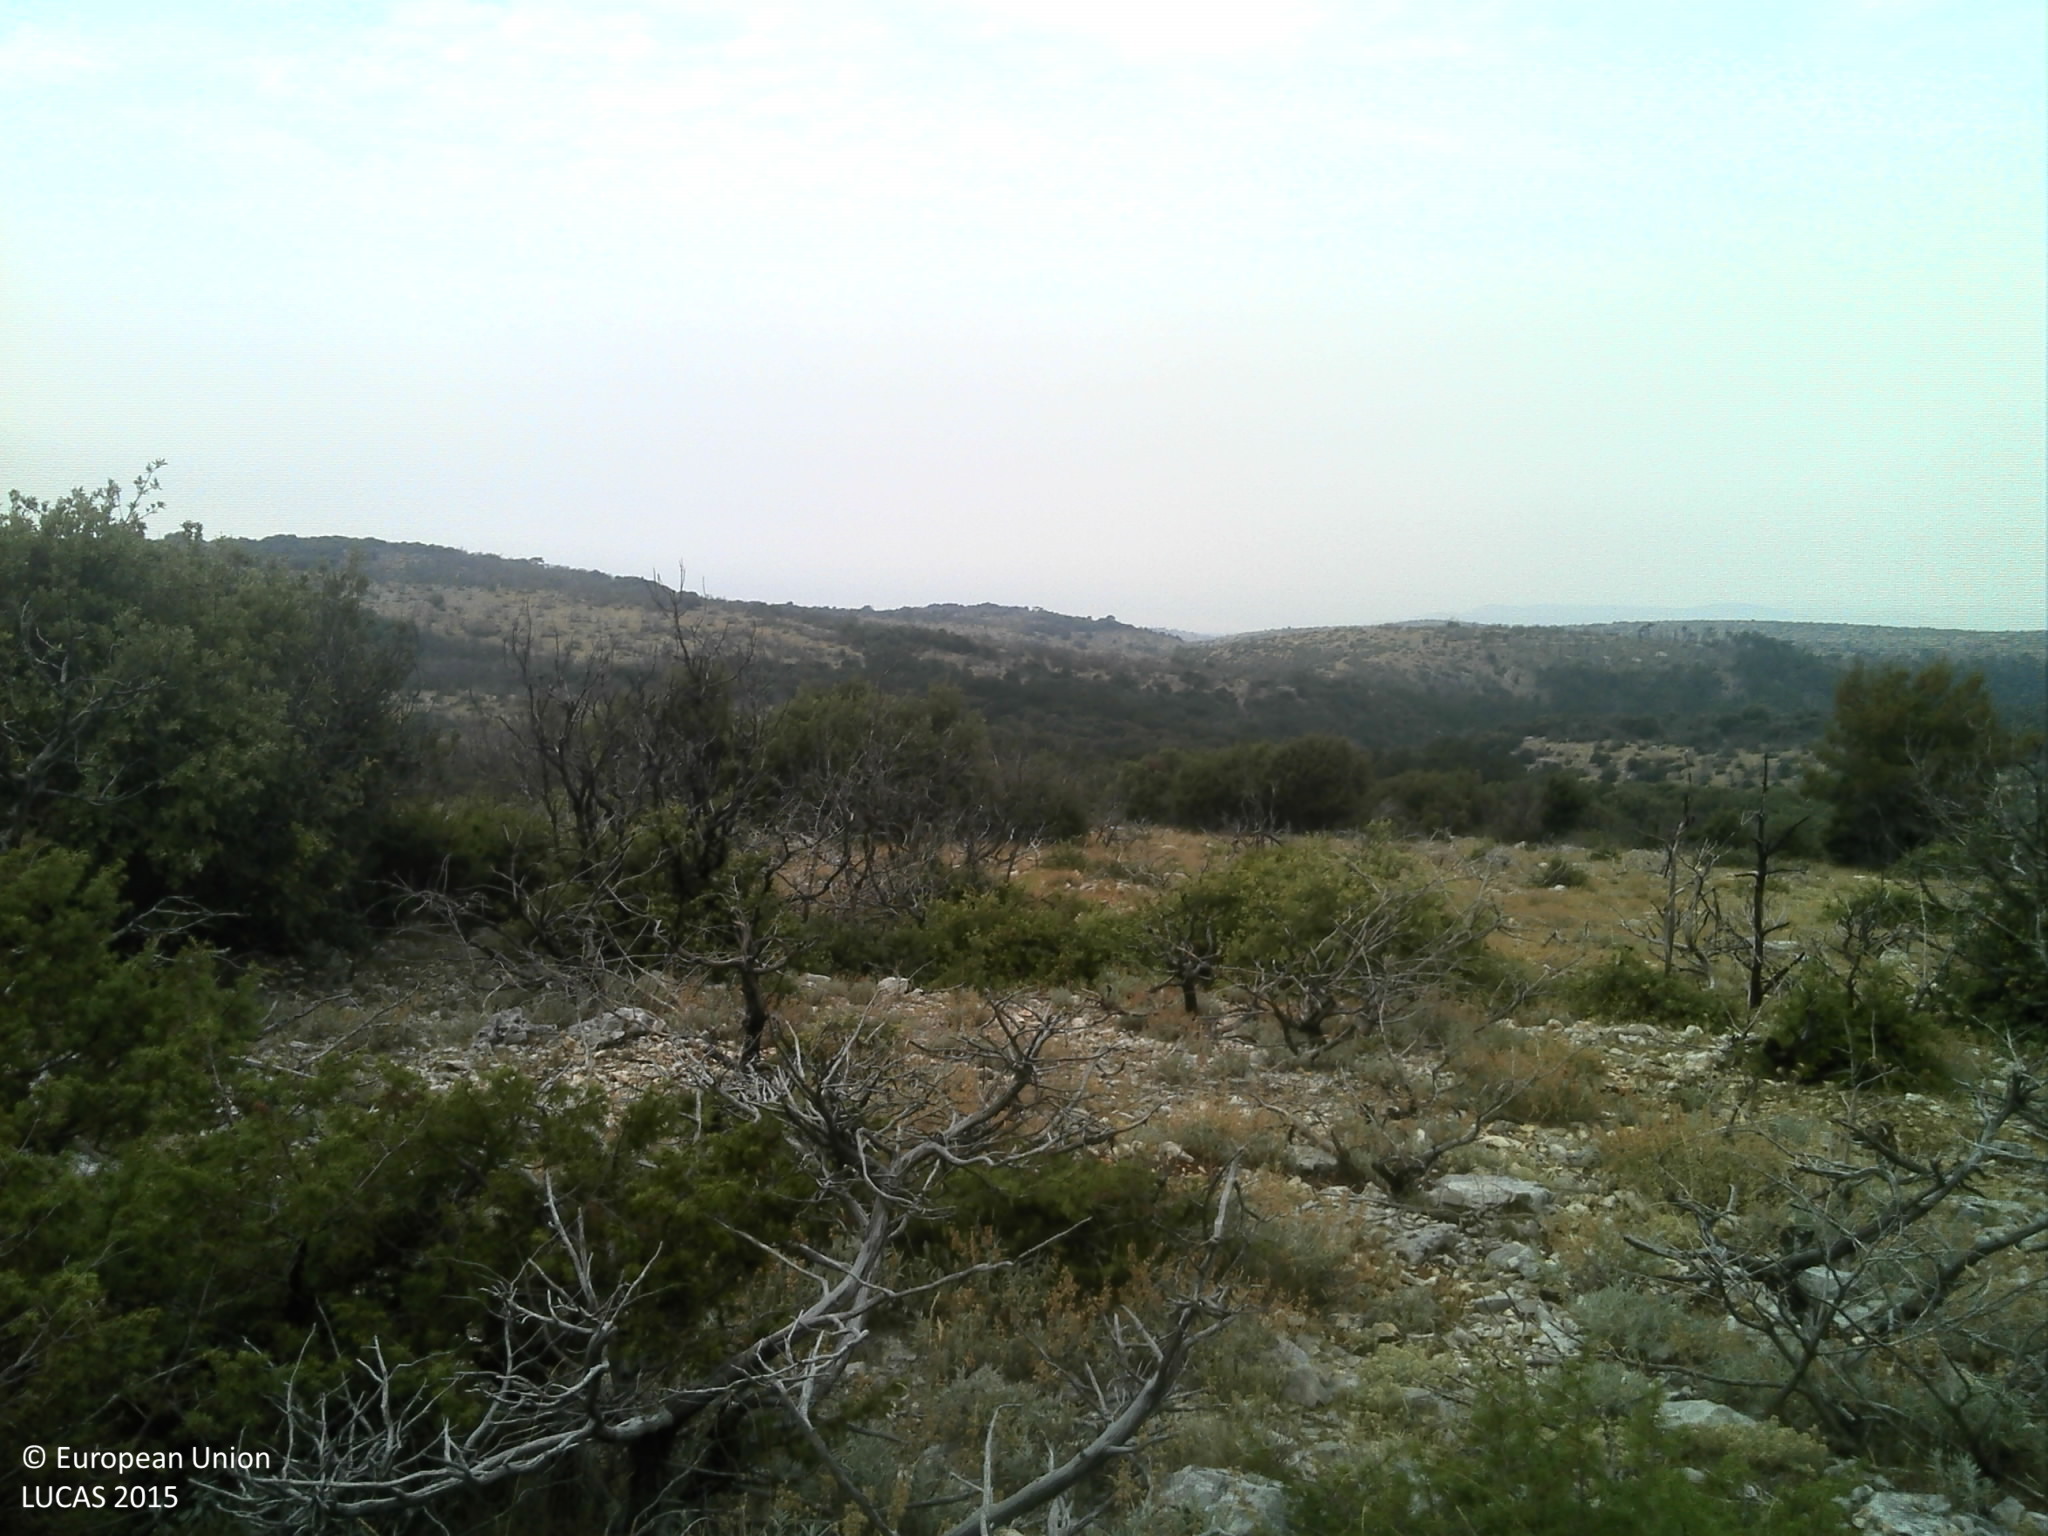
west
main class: Shrubland
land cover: Shrubland with sparse tree cover
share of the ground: > 75 %
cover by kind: shrubs 55 %, unconsolidated bare surface 20 %, herbaceous plants 15 %, broadleaved forest trees 5 %, consolidated bare surface 5 %
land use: Semi-natural and natural areas not in use
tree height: < 5 m
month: July
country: HR
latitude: 43.3104
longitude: 16.5614
